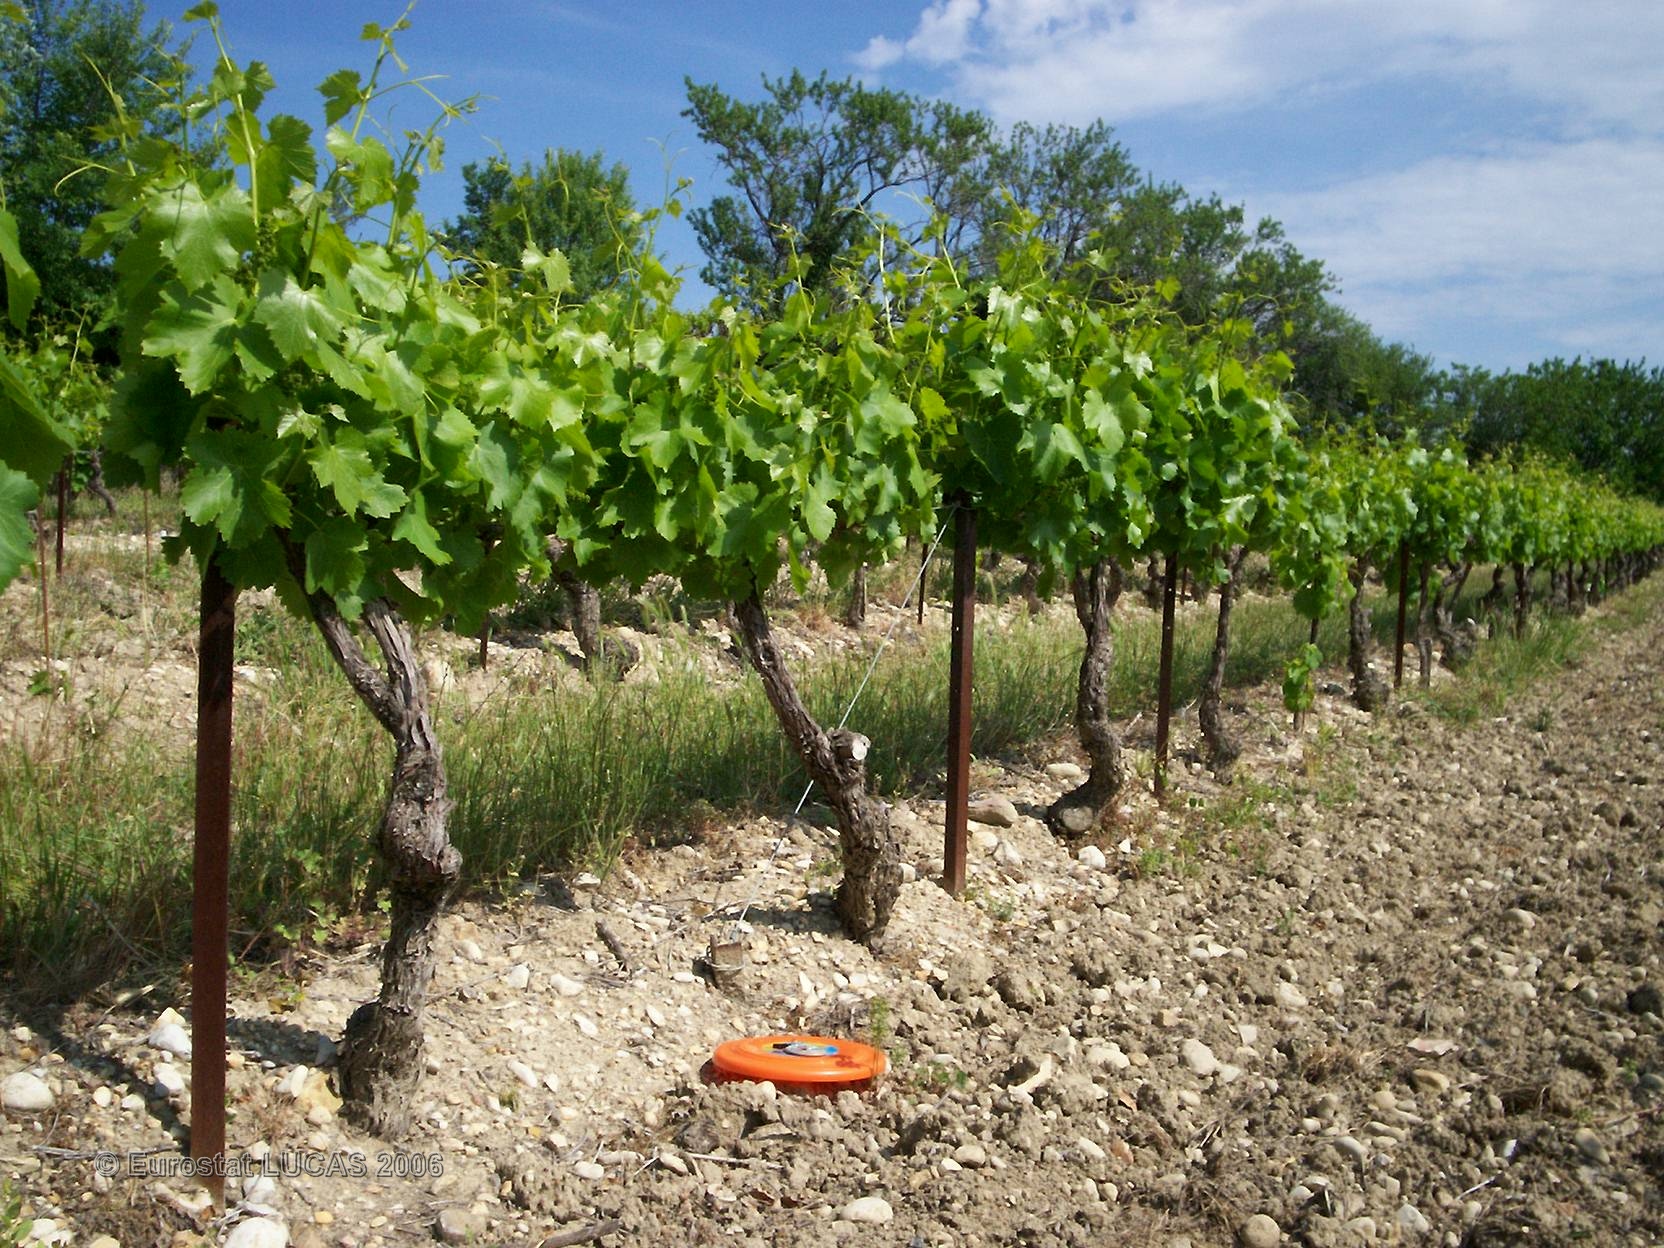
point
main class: Cropland
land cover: Vineyards
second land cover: Grassland with sparse tree/shrub cover
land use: Agriculture (excluding fallow land and kitchen gardens)
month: May
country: FR
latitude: 44.3182
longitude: 4.9546
